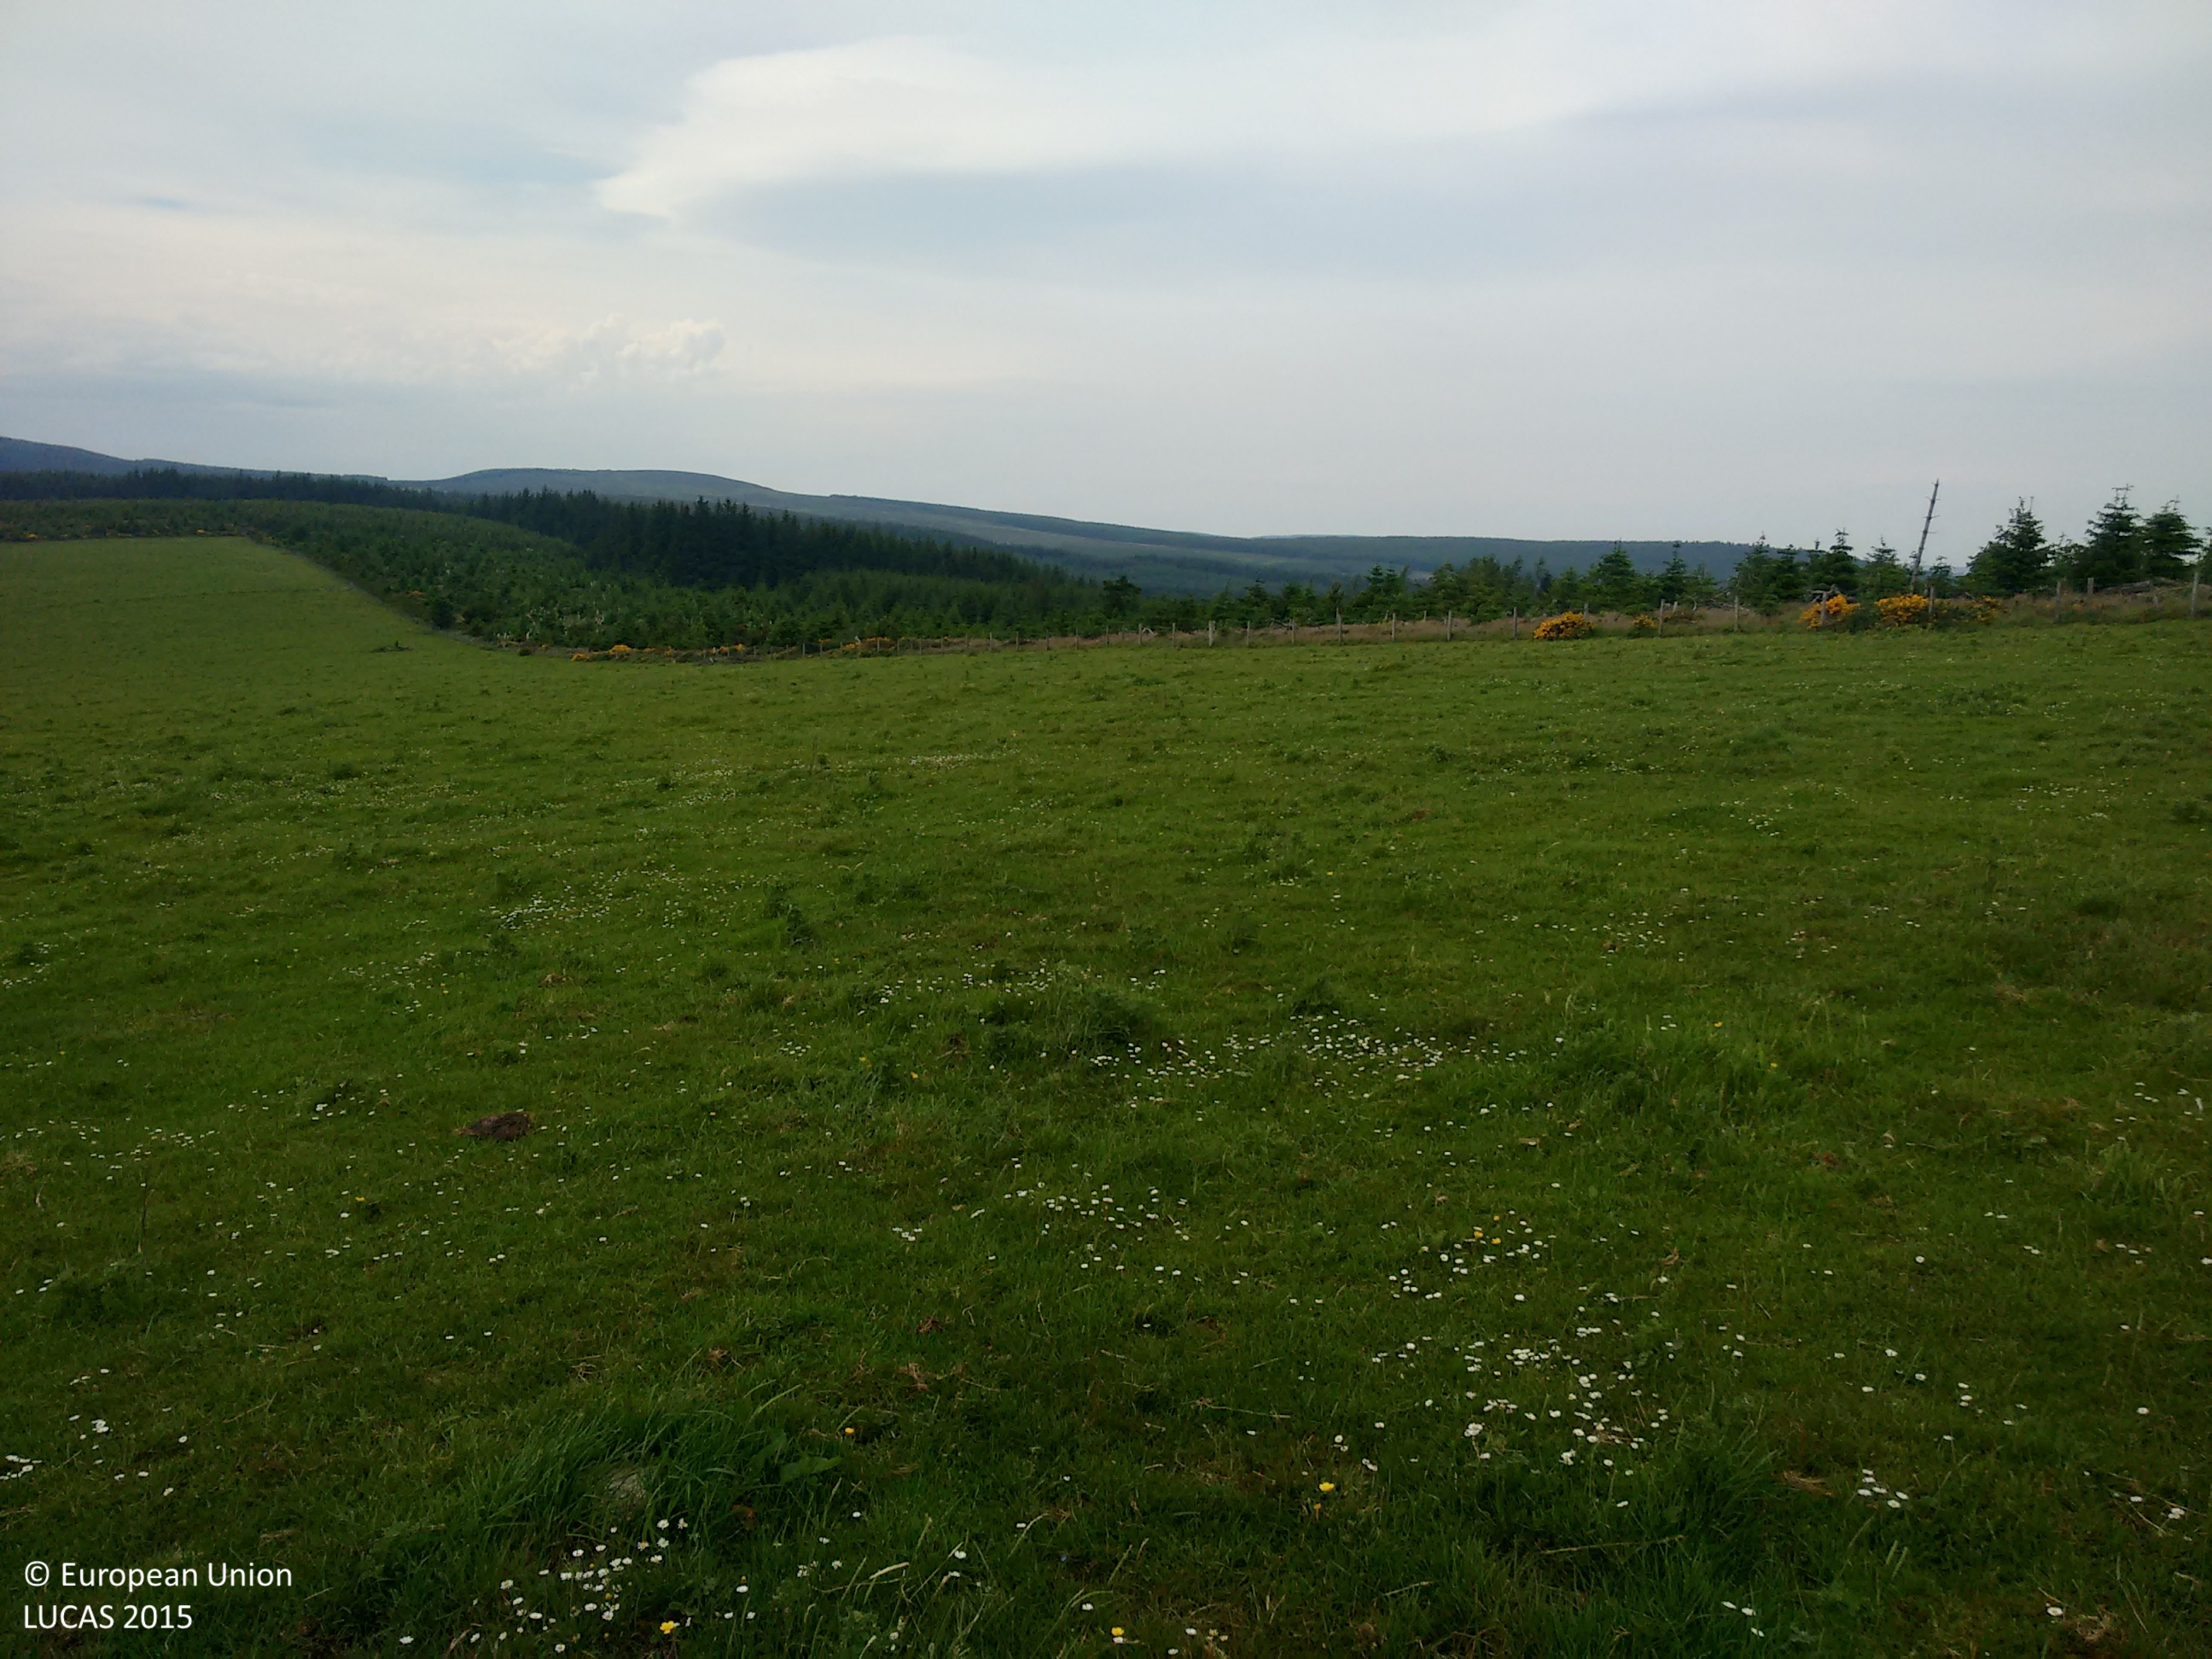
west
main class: Grassland
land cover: Grassland without tree/shrub cover
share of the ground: > 75 %
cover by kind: herbaceous plants 100 %
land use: Agriculture (excluding fallow land and kitchen gardens)
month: July
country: GB
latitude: 57.4156
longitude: -2.8621
